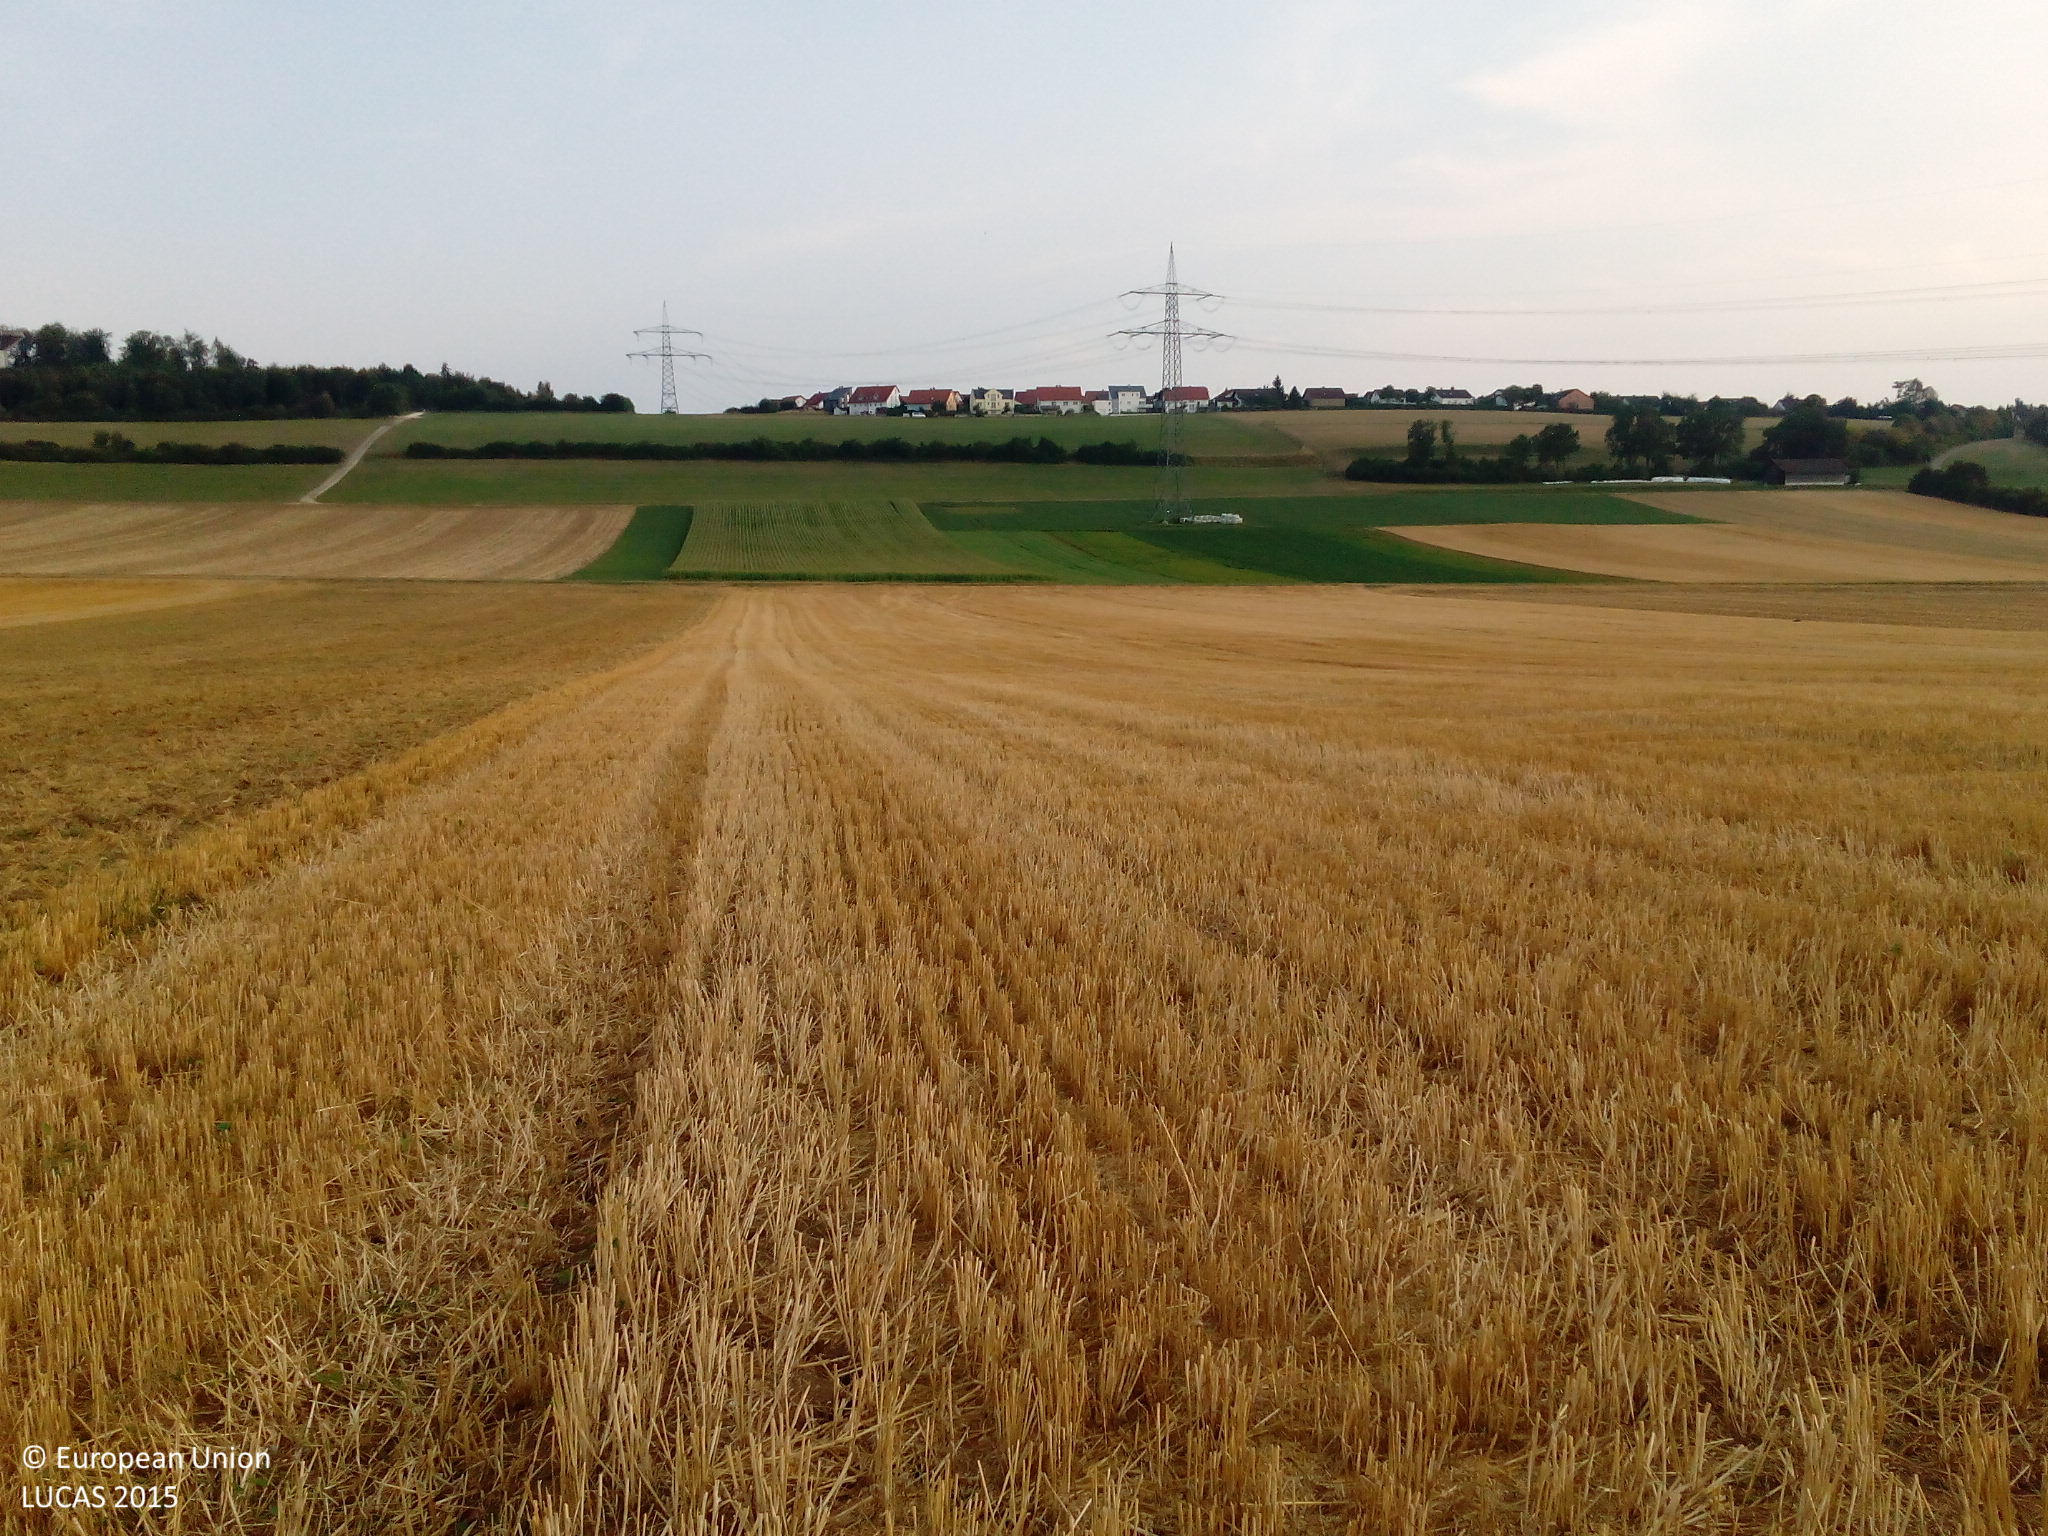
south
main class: Cropland
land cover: Common wheat
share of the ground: > 75 %
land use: Agriculture (excluding fallow land and kitchen gardens)
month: August
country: DE
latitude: 48.7090
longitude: 10.2581
